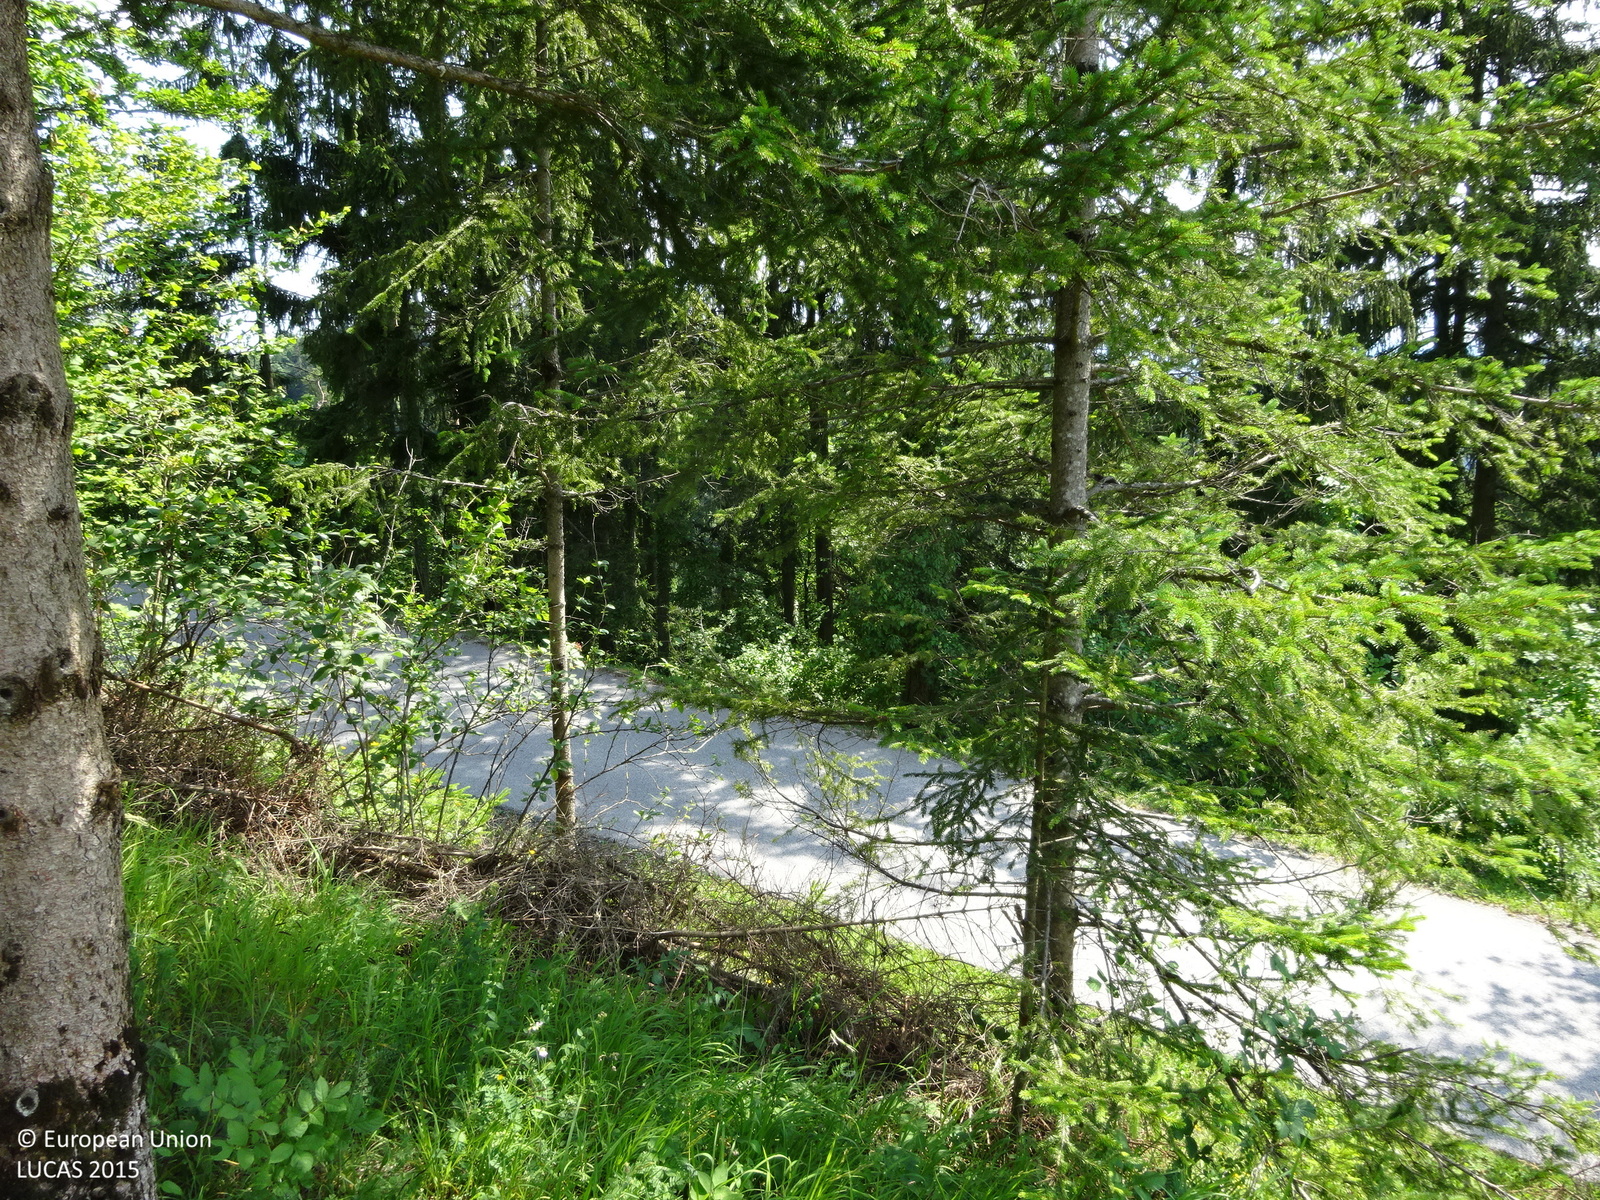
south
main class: Woodland
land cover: Spruce dominated coniferous woodland
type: alpine coniferous forest
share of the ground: 50 - 75 %
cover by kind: coniferous forest trees 70 %, shrubs 25 %, broadleaved forest trees 5 %
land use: Forestry
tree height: < 5 m
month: July
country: AT
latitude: 47.1279
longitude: 15.1802
